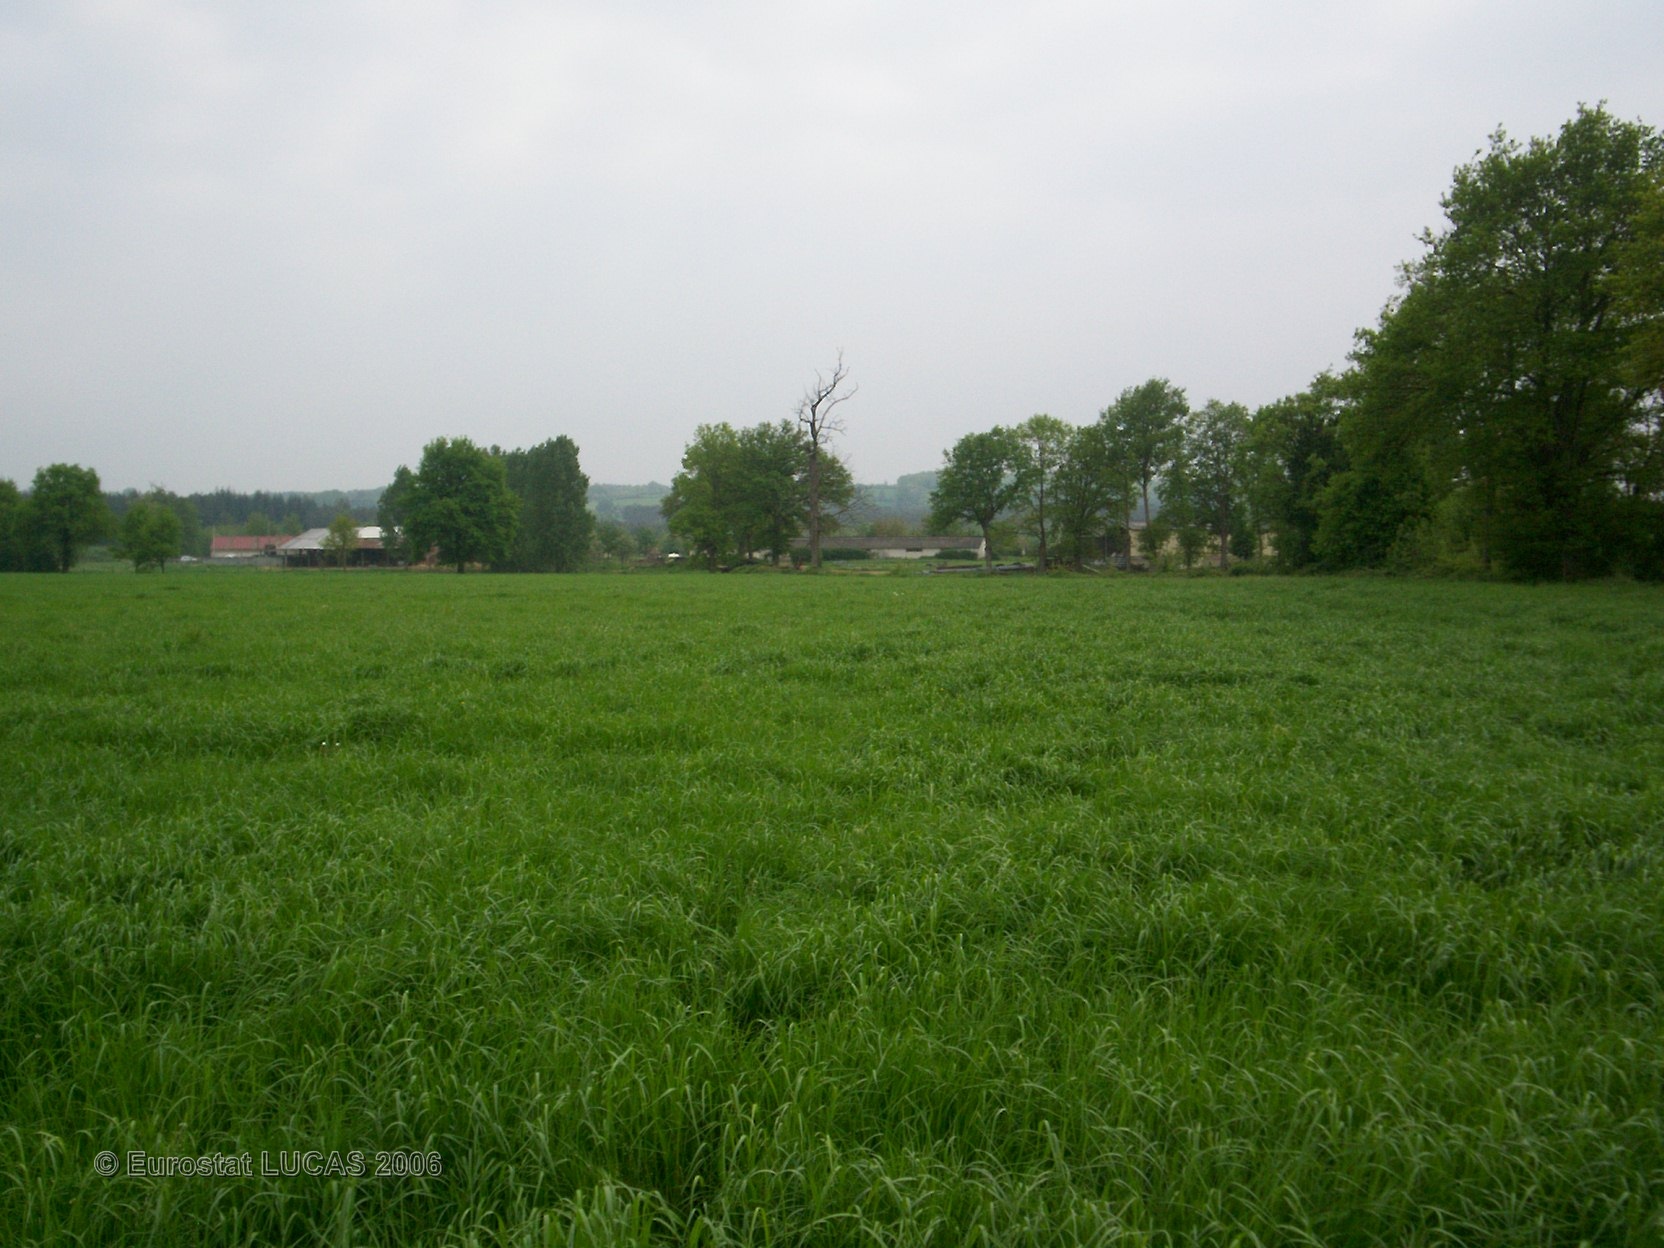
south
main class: Grassland
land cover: Grassland without tree/shrub cover
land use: Agriculture (excluding fallow land and kitchen gardens)
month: May
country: FR
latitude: 47.8682
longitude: 0.3099
